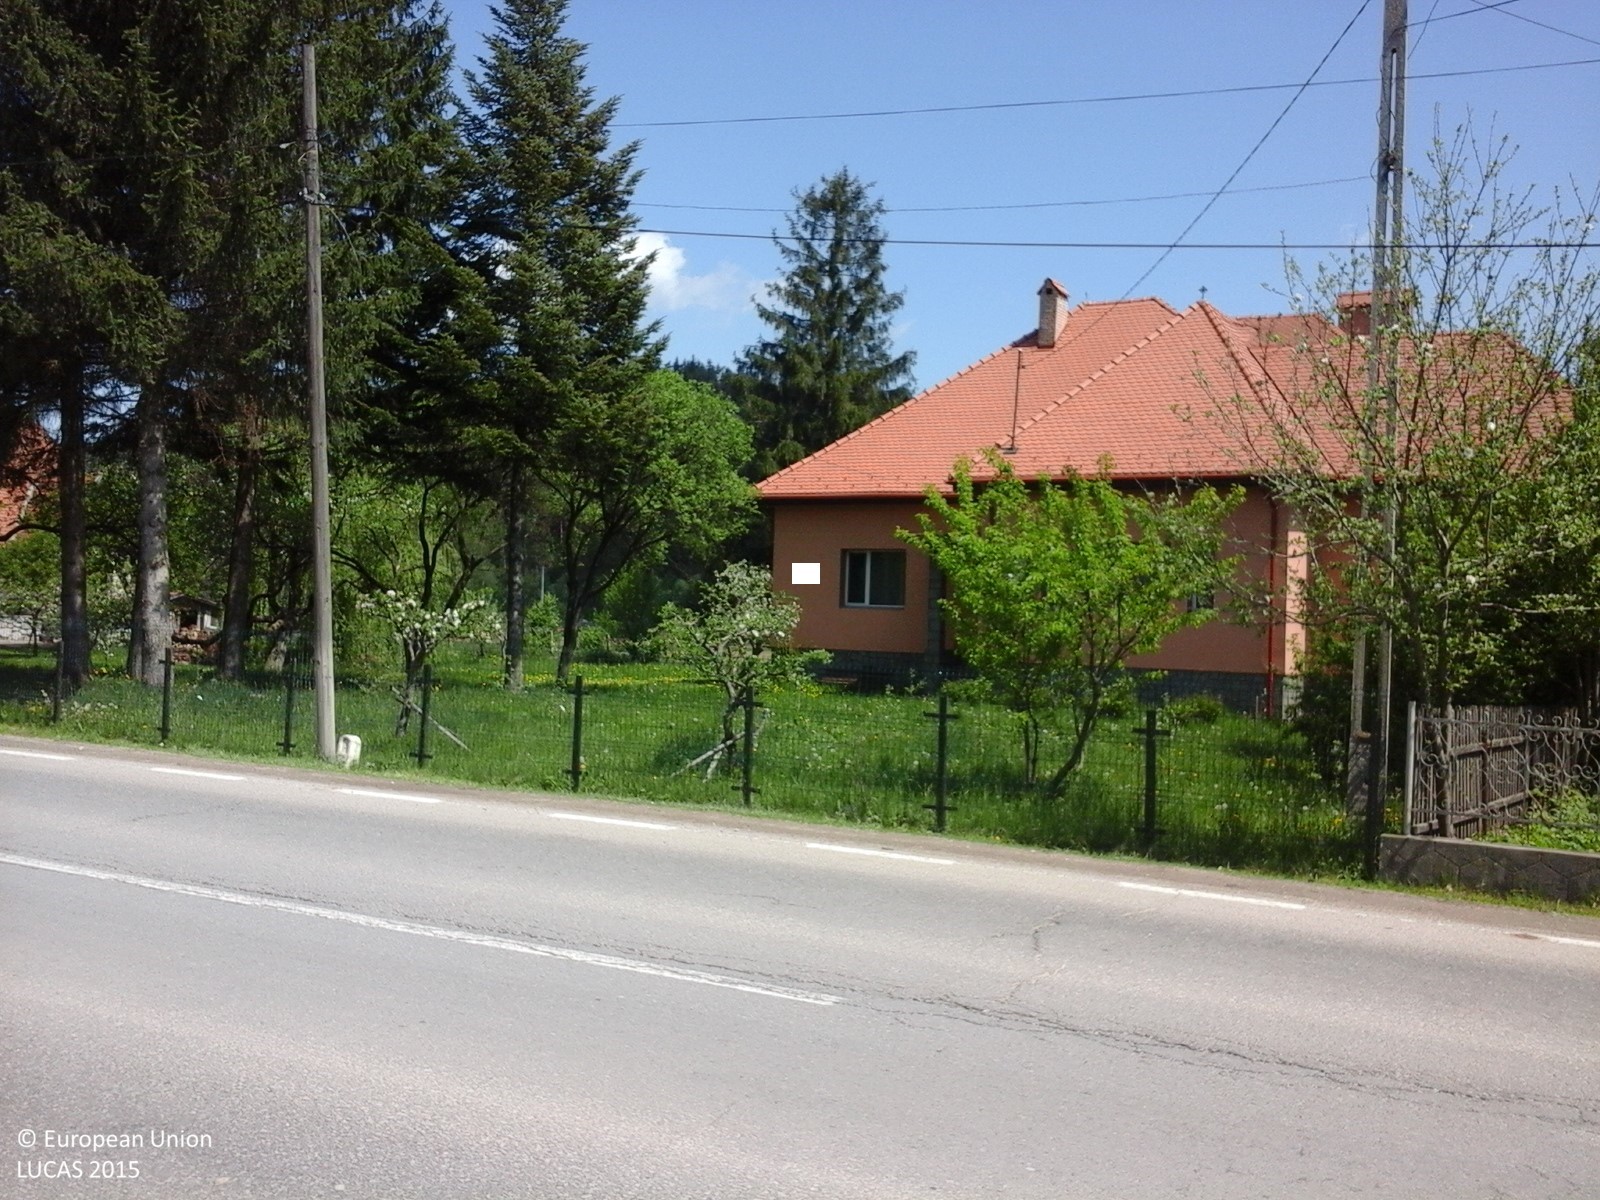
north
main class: Cropland
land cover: Other fruit trees and berries
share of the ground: 10 - 25 %
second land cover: Grassland without tree/shrub cover
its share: > 75 %
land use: Kitchen garden
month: May
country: RO
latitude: 45.6585
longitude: 26.0682
